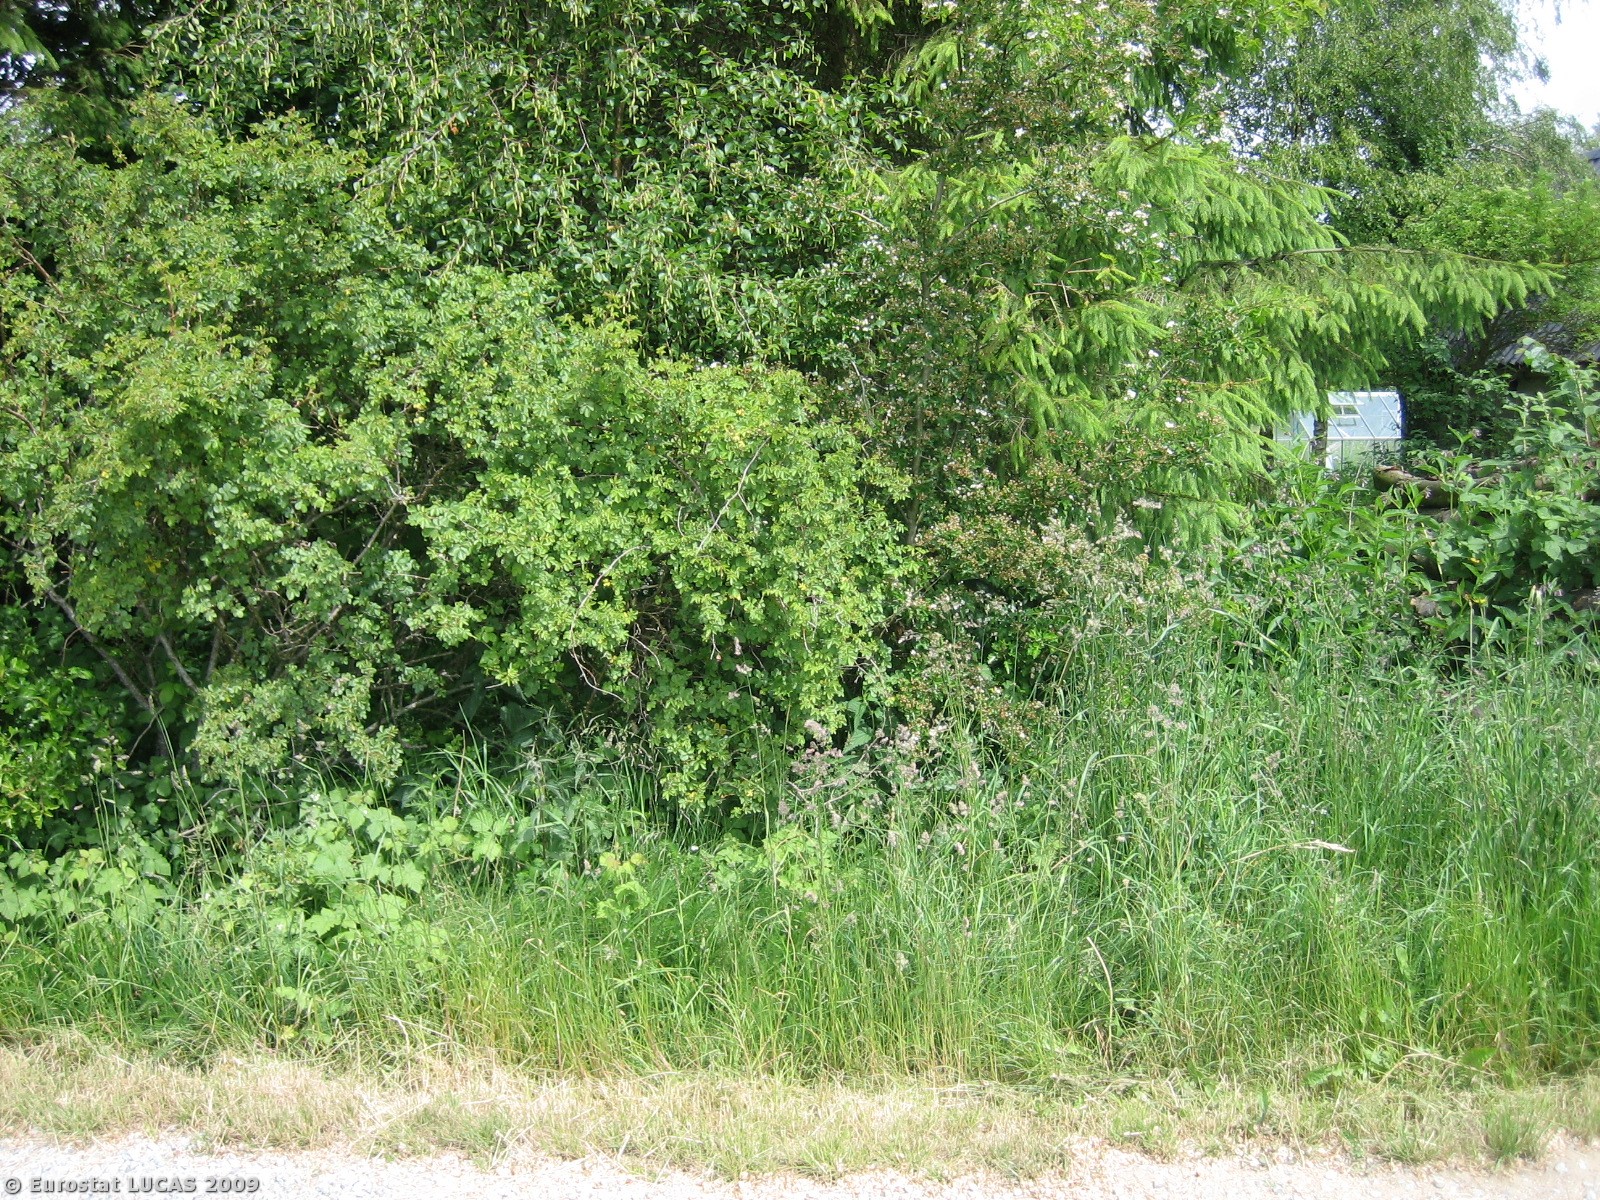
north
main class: Cropland
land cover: Rye
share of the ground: > 75 %
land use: Agriculture (excluding fallow land and kitchen gardens)
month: June
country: DK
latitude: 56.2775
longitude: 10.1452
